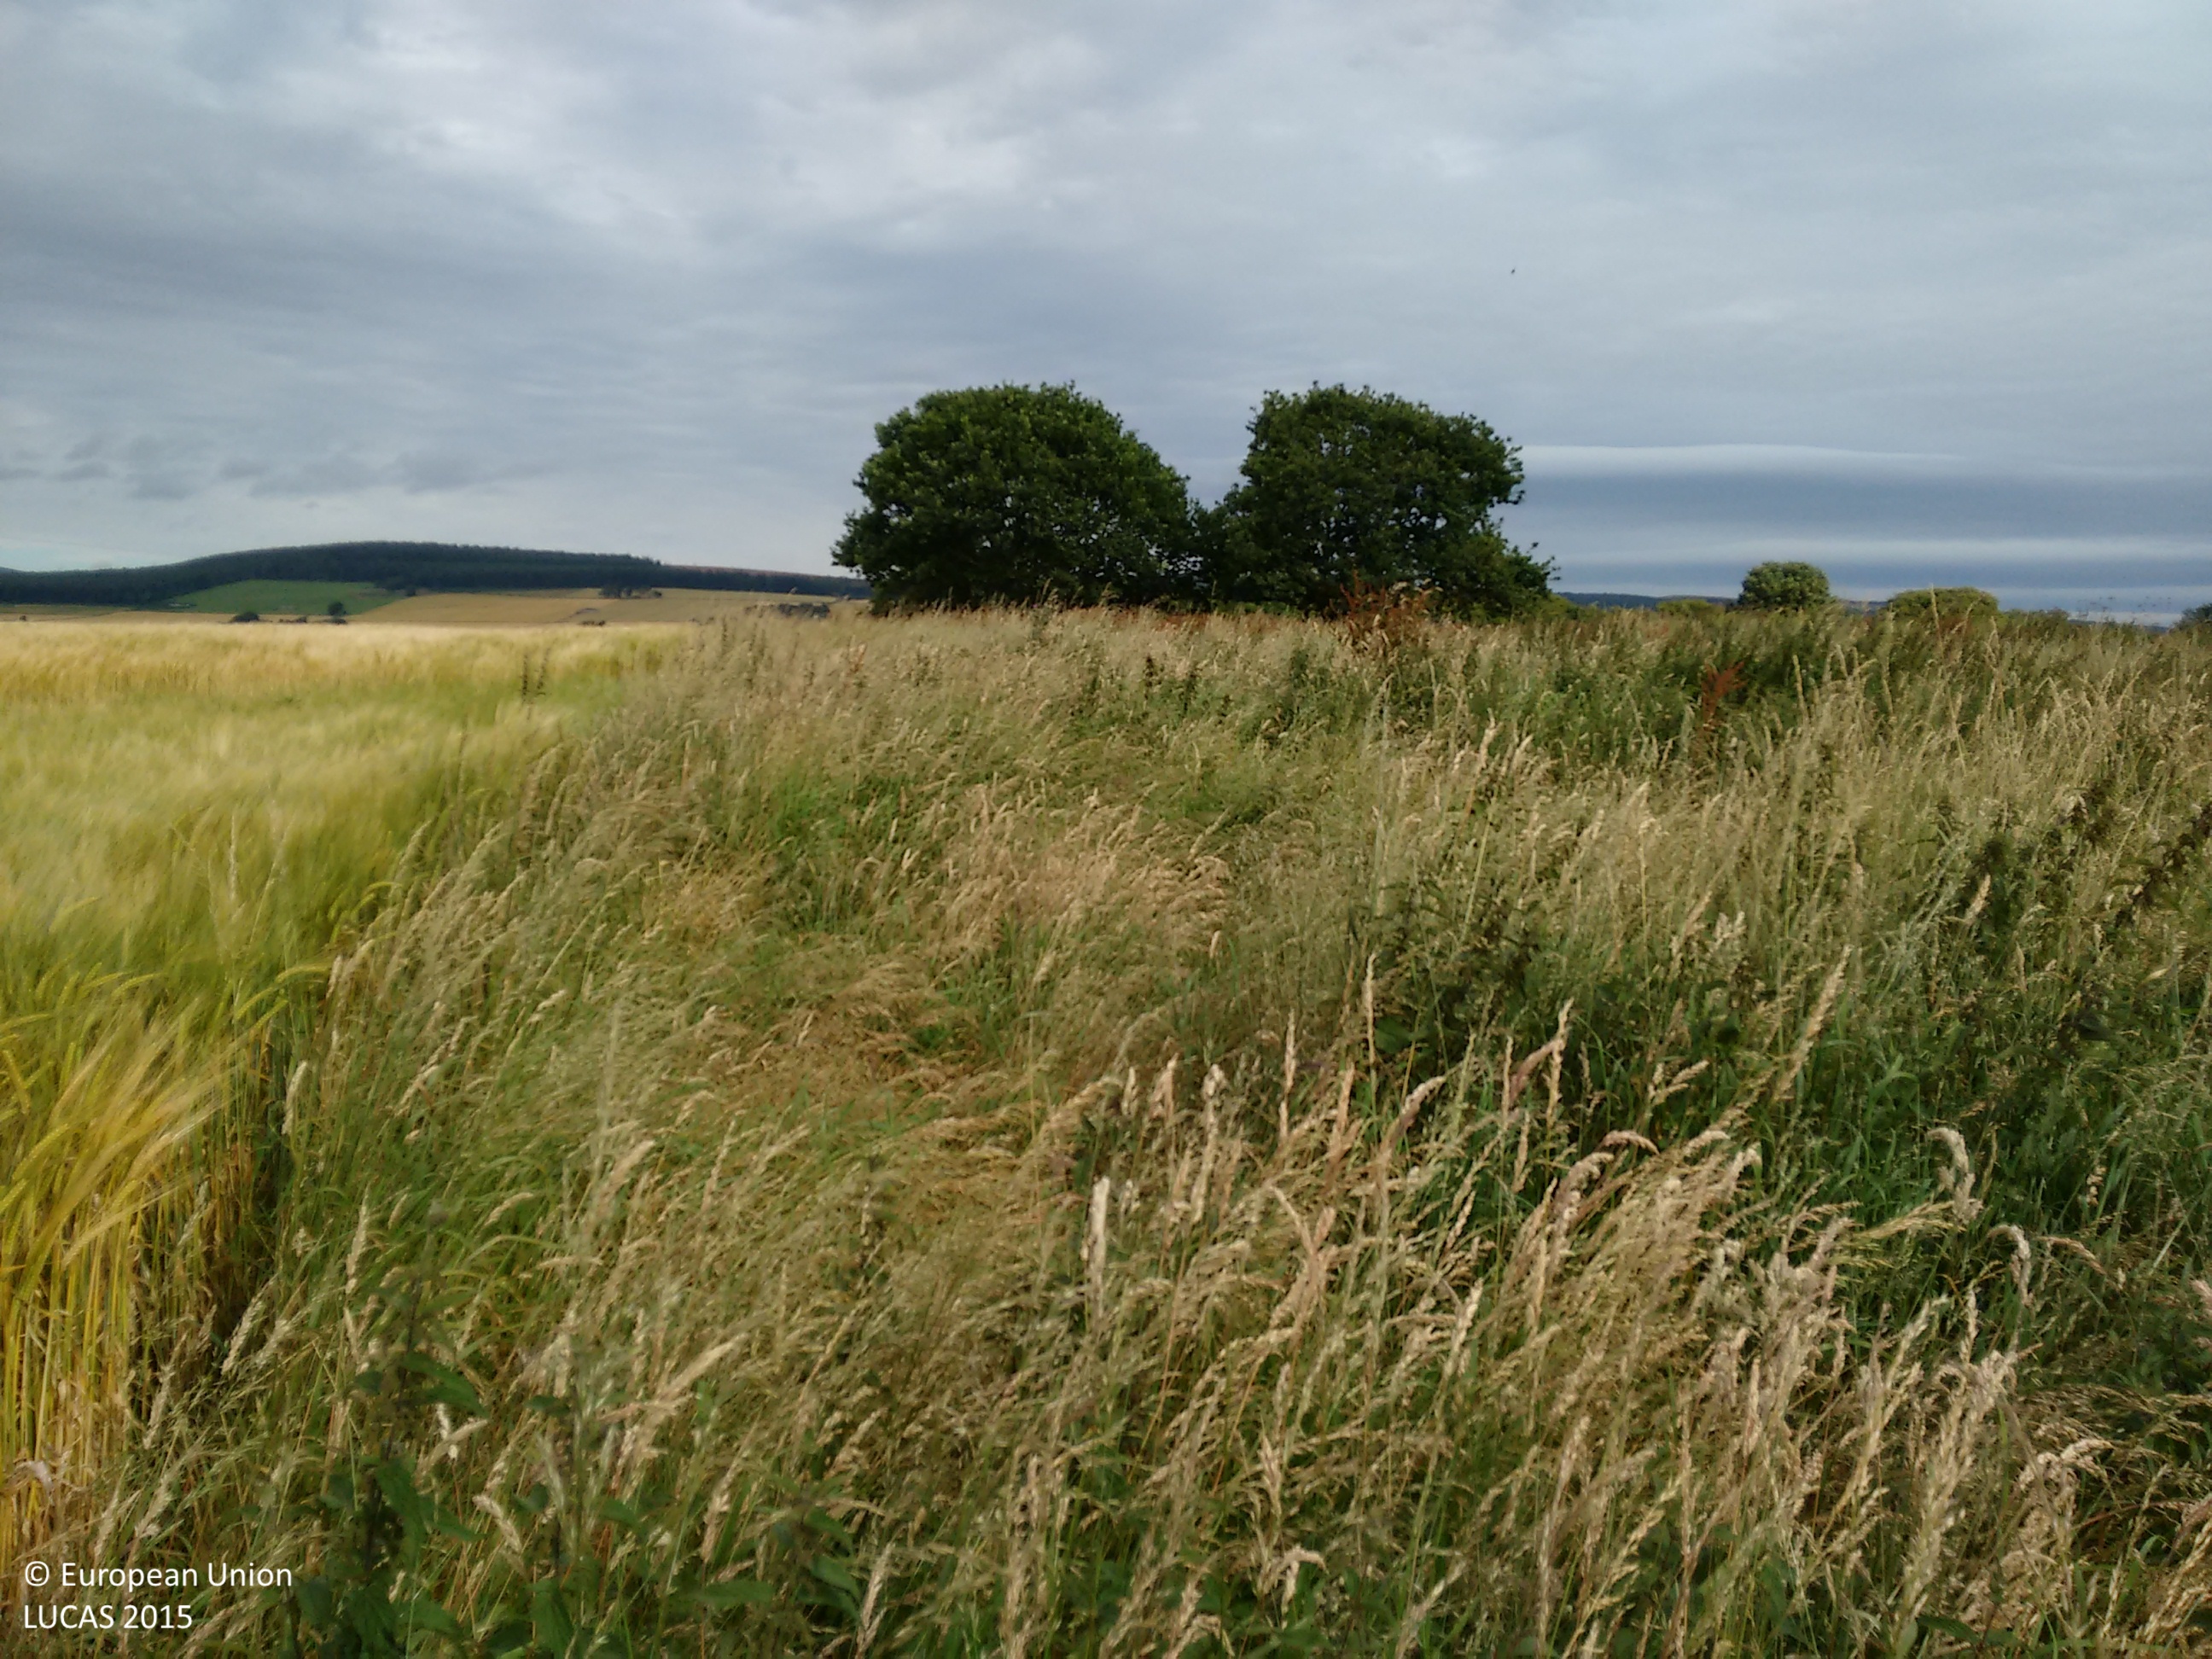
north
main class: Cropland
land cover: Barley
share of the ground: > 75 %
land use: Agriculture (excluding fallow land and kitchen gardens)
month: August
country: GB
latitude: 57.6952
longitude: -4.2269
